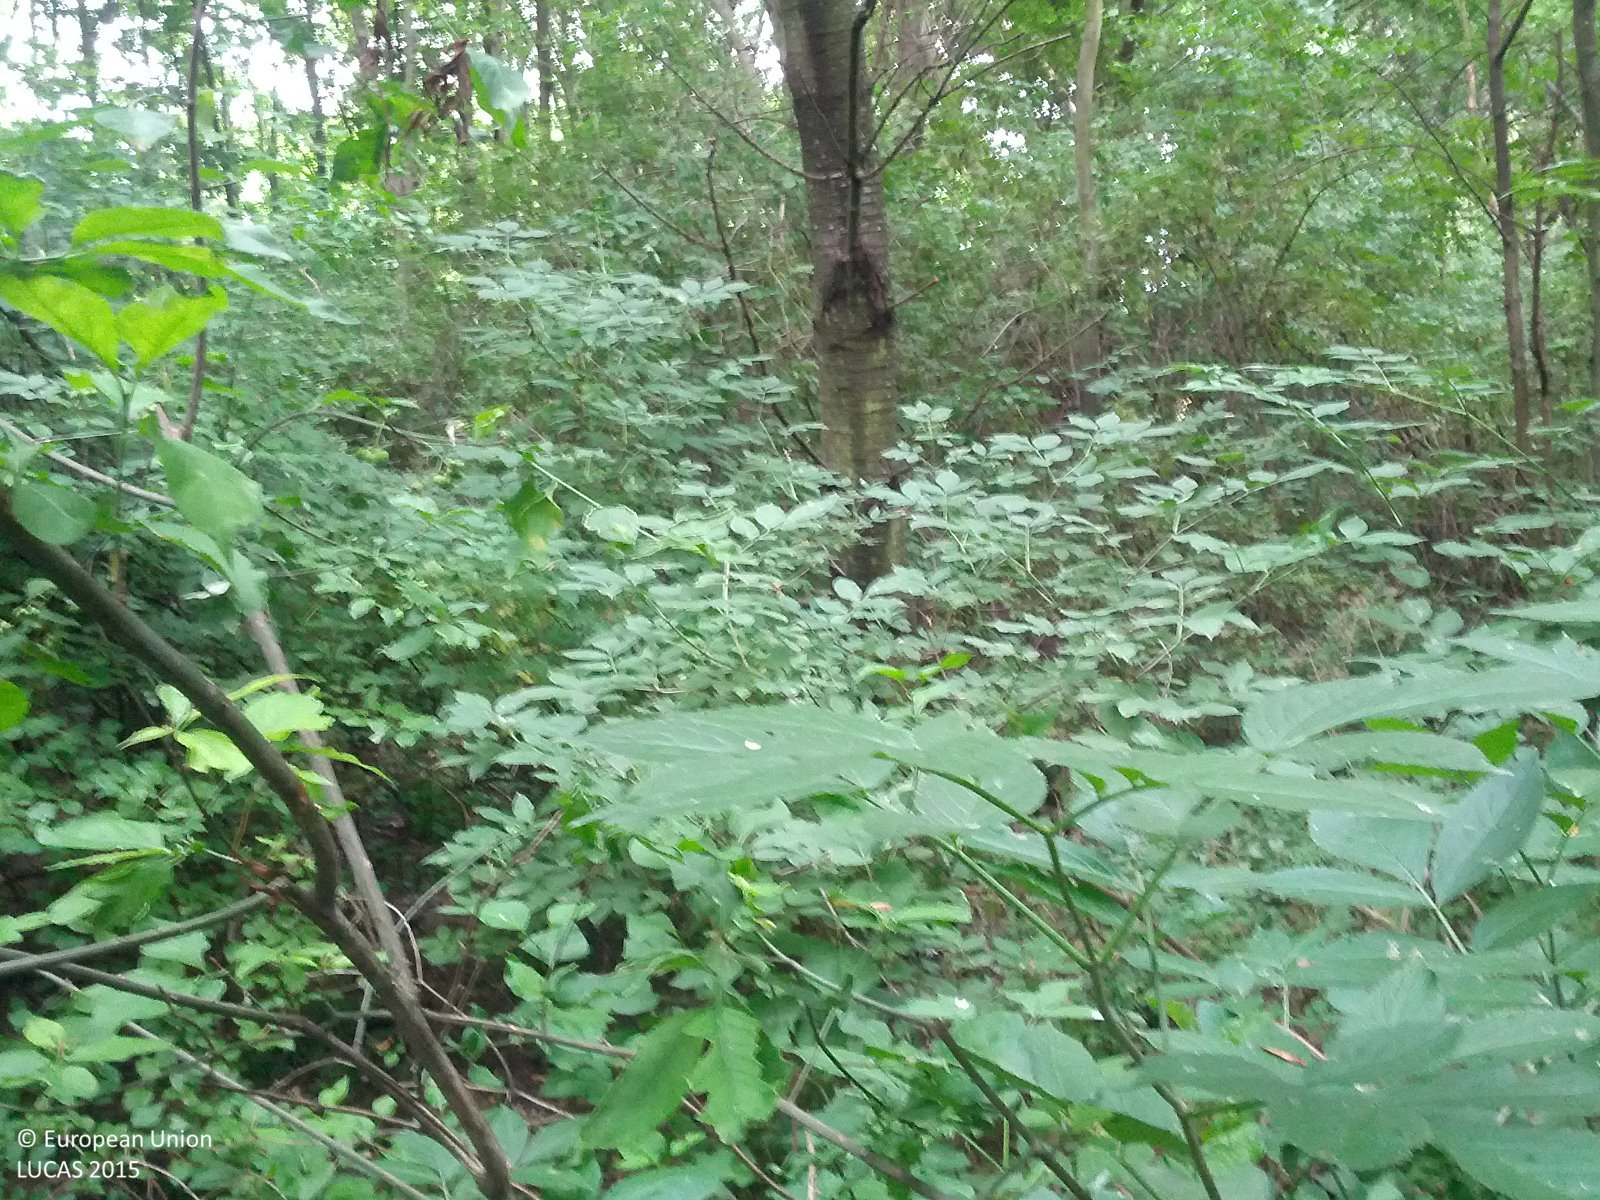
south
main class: Woodland
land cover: Broadleaved woodland
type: floodplain forest
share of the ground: > 75 %
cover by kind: broadleaved forest trees 75 %, shrubs 15 %, herbaceous plants 10 %
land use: Semi-natural and natural areas not in use
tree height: > 5 m
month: July
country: AT
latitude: 48.7655
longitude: 16.6053
